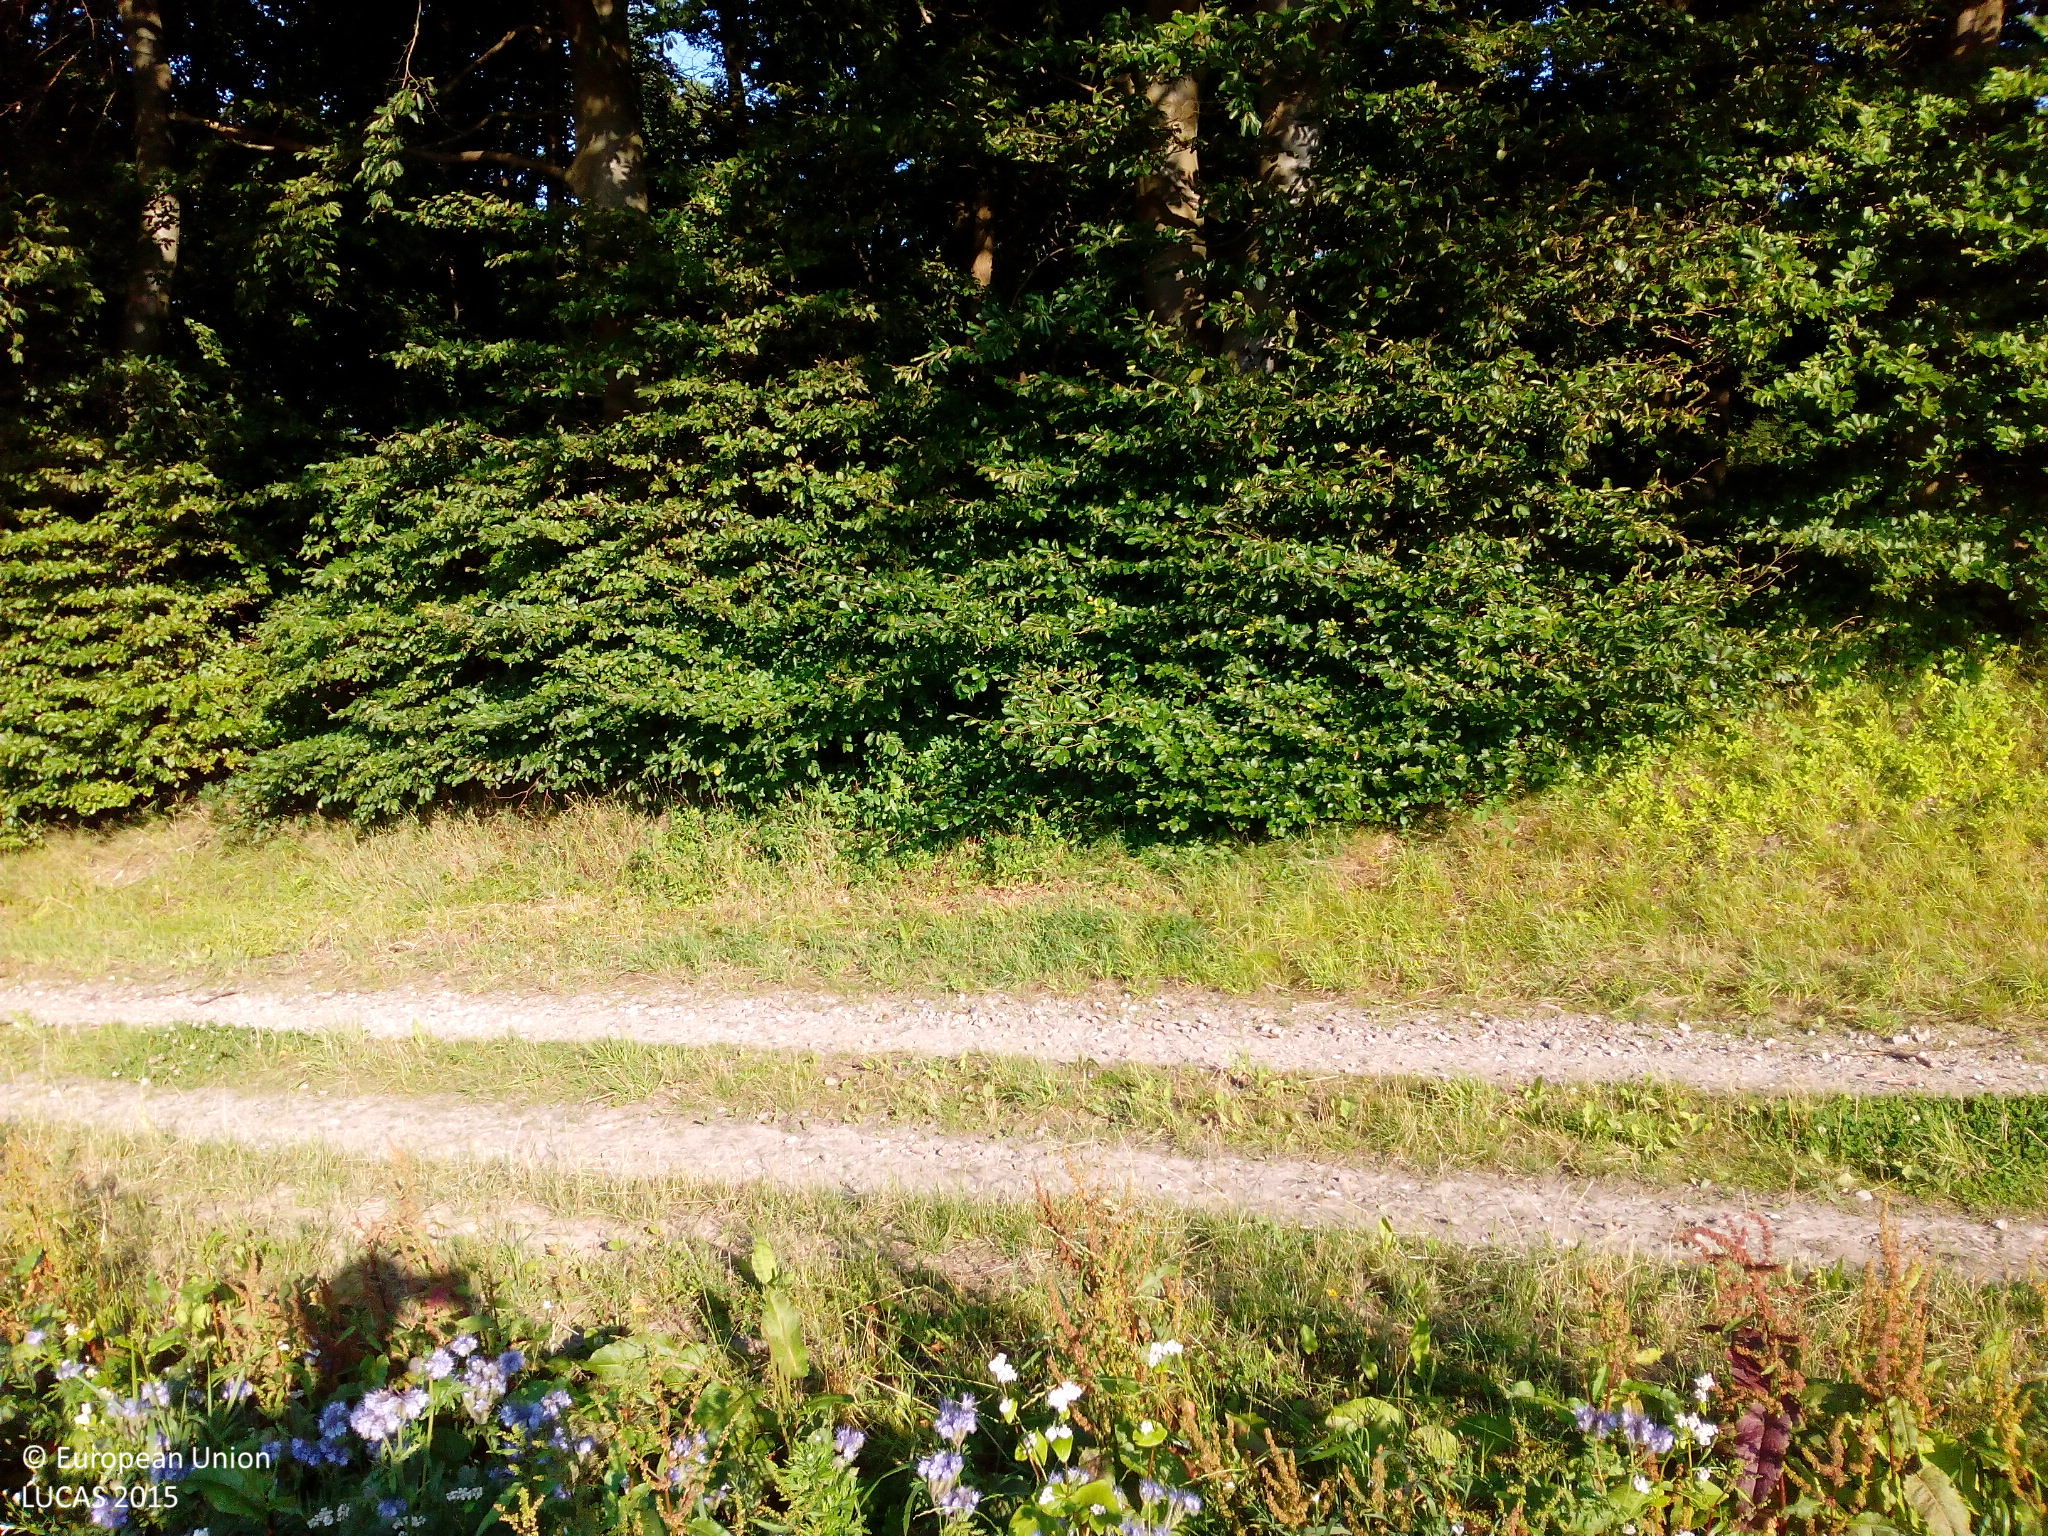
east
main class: Cropland
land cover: Lucerne
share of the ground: > 75 %
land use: Agriculture (excluding fallow land and kitchen gardens)
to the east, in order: Lucerne; Grass margins; Tracks; Broadleaved woodland; Ditches and canals; Spruce dominated mixed woodland; Tracks; Spruce dominated coniferous woodland; Tracks; Broadleaved woodland; Paved roads, cycling and walking lanes; Grass margins; Barley
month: August
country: DK
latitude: 55.6709
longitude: 11.8586
